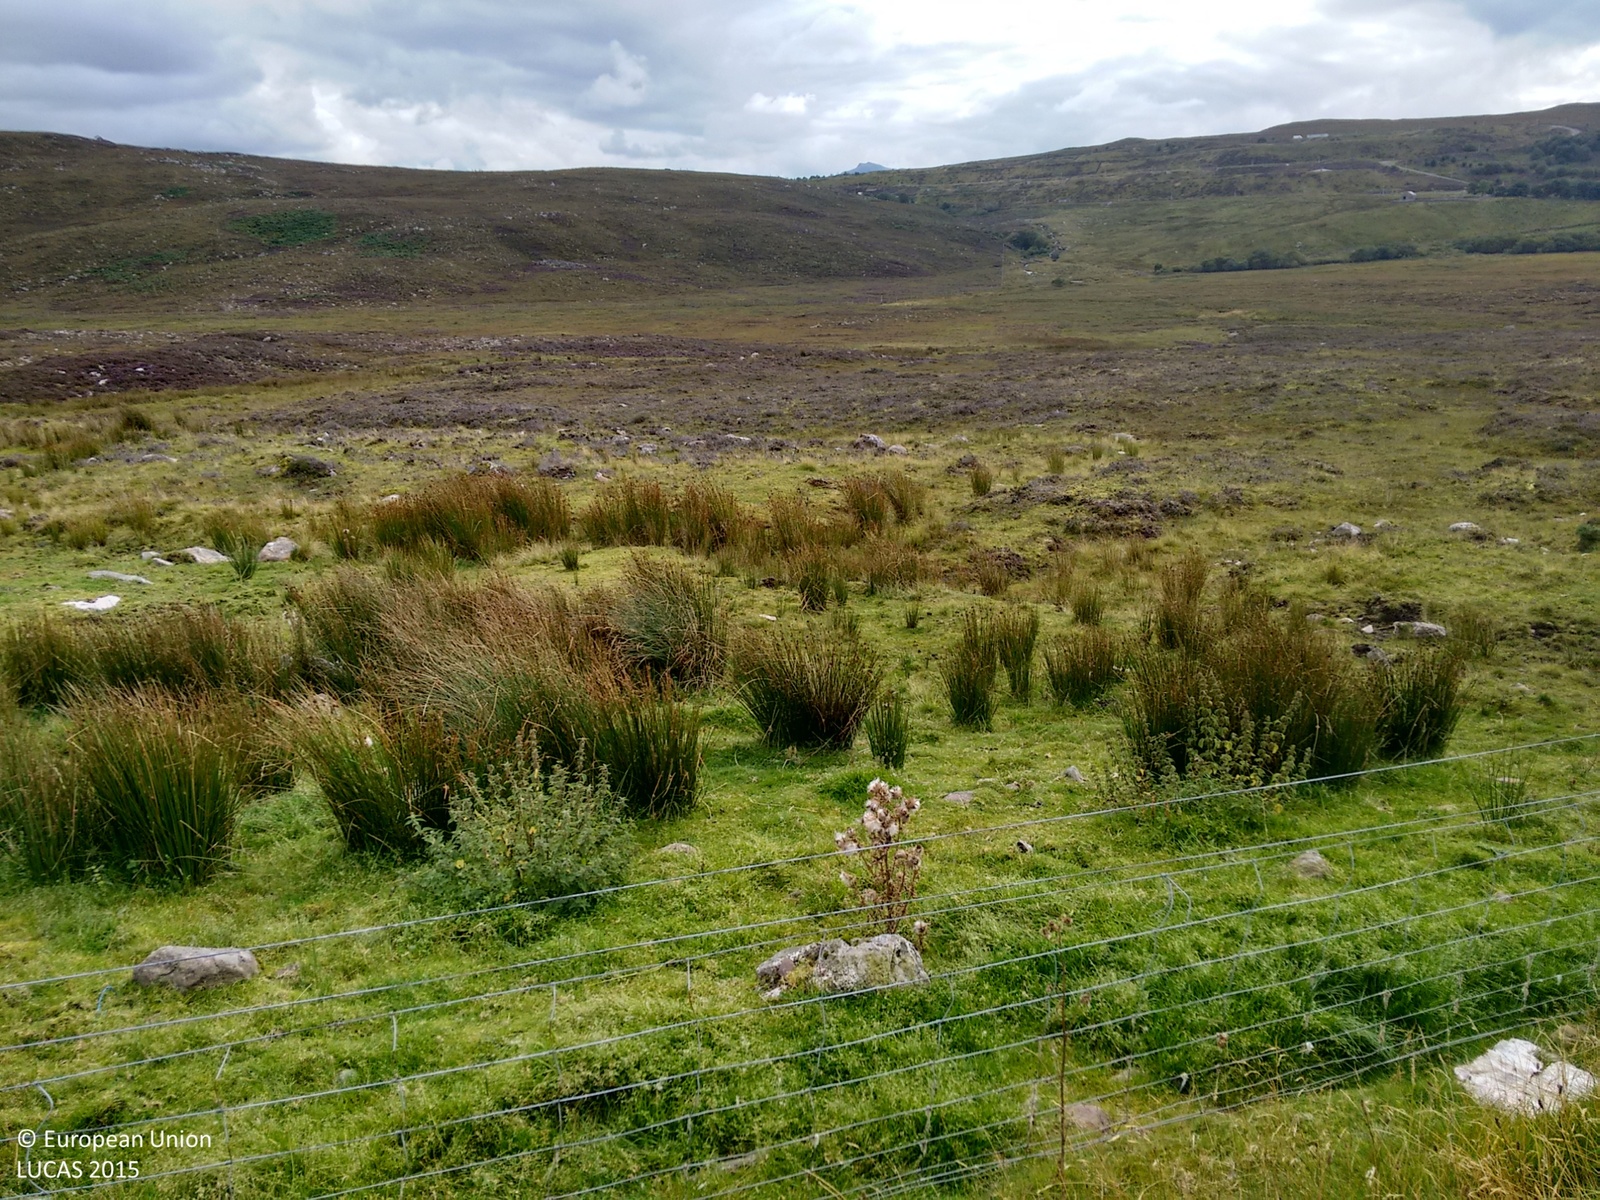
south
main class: Shrubland
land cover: Shrubland without tree cover
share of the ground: > 75 %
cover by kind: shrubs 80 %, herbaceous plants 20 %
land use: Agriculture (excluding fallow land and kitchen gardens)
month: September
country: GB
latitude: 57.8377
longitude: -5.5597
